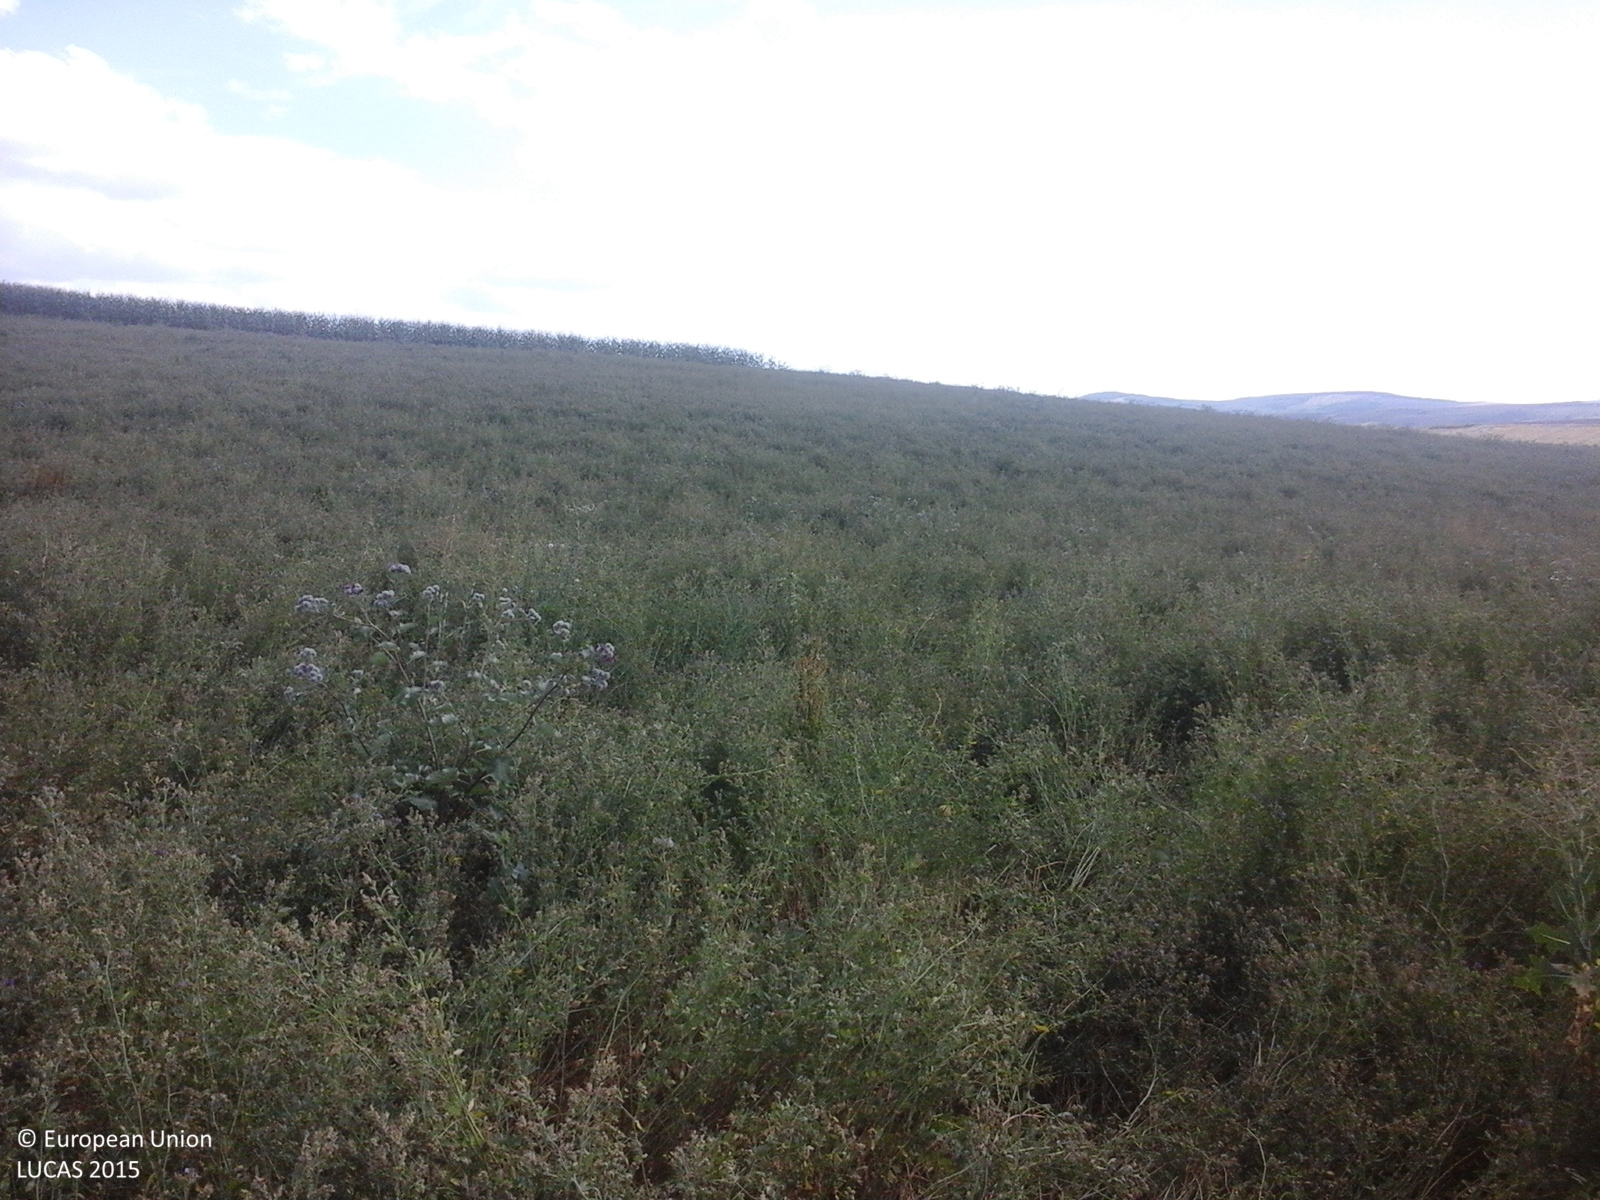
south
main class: Cropland
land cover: Lucerne
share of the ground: > 75 %
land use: Agriculture (excluding fallow land and kitchen gardens)
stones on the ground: < 10 %
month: July
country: RO
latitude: 46.5859
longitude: 27.4007
